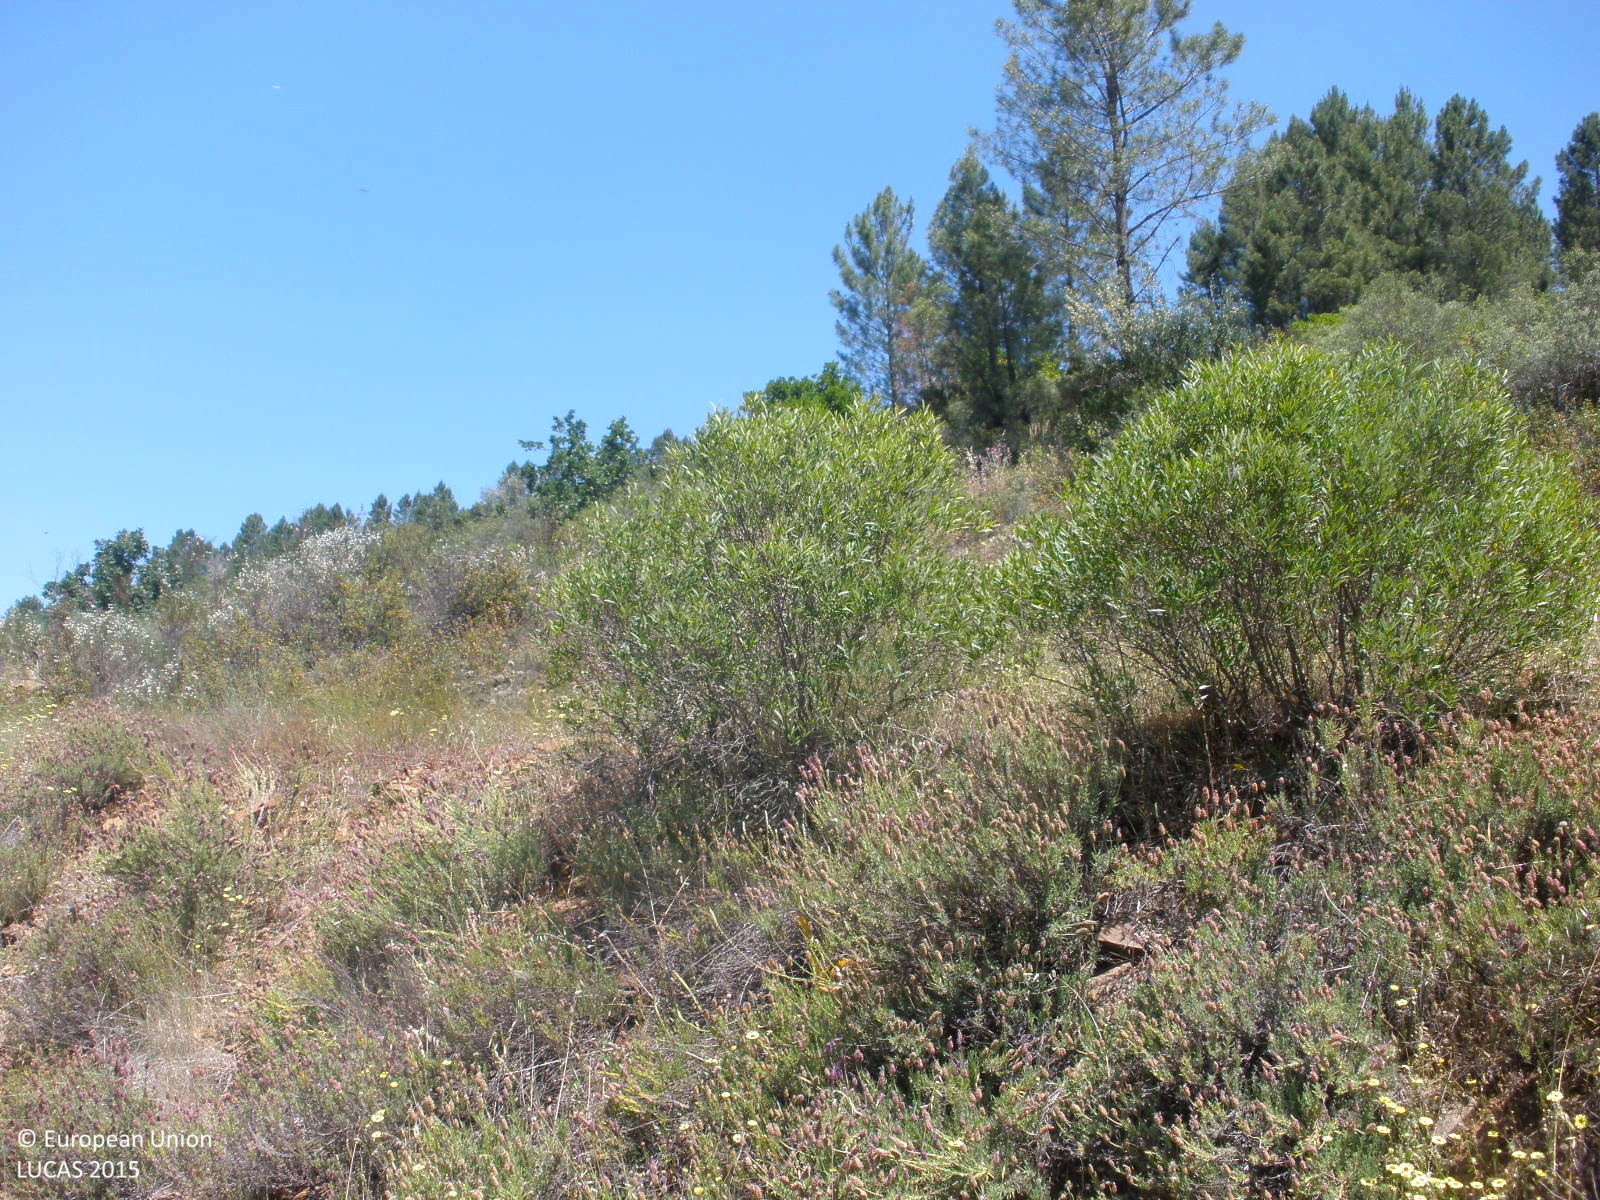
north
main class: Woodland
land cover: Other mixed woodland
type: coniferous forest of the mediterranean region
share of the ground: > 75 %
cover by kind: broadleaved forest trees 50 %, shrubs 30 %, coniferous forest trees 20 %
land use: Semi-natural and natural areas not in use
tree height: > 5 m
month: May
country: ES
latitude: 40.4484
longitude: -6.0297
